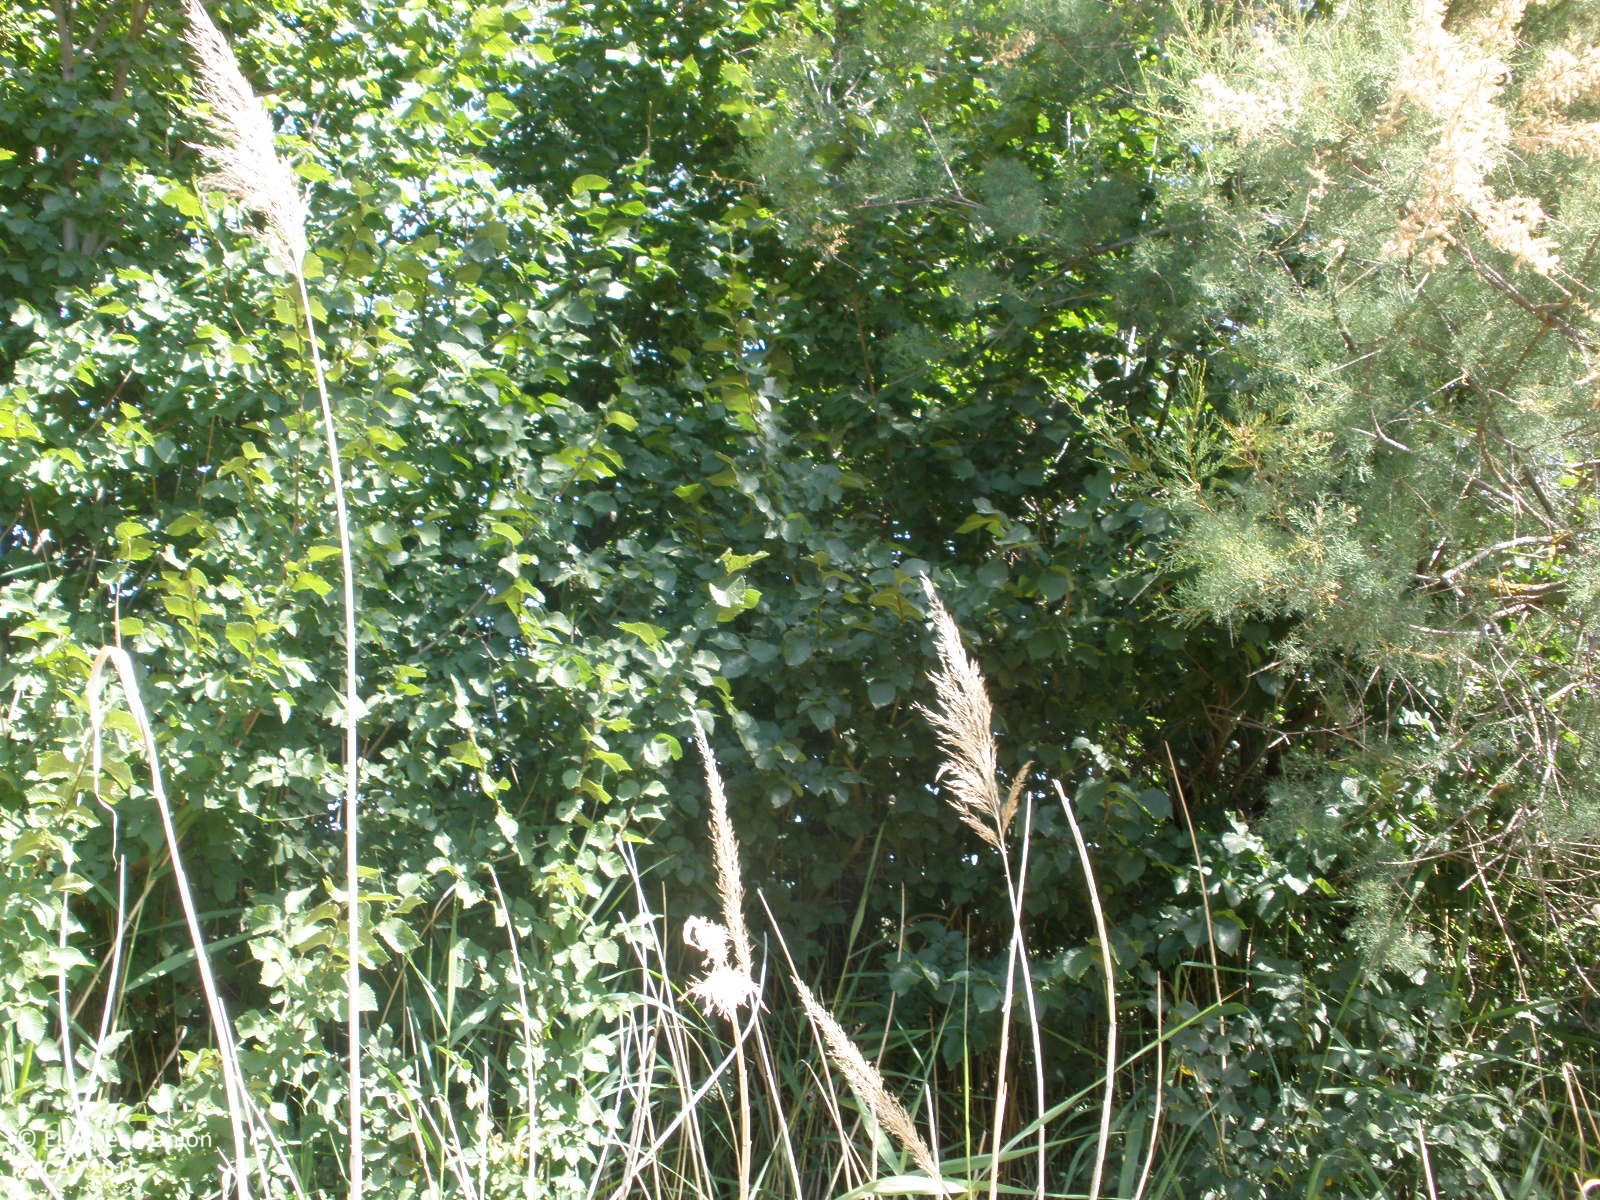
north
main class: Grassland
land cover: Spontaneously vegetated surfaces
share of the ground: 10 - 25 %
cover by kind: unconsolidated bare surface 80 %, herbaceous plants 20 %
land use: Fallow land
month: June
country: ES
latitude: 40.0854
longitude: -3.1974
